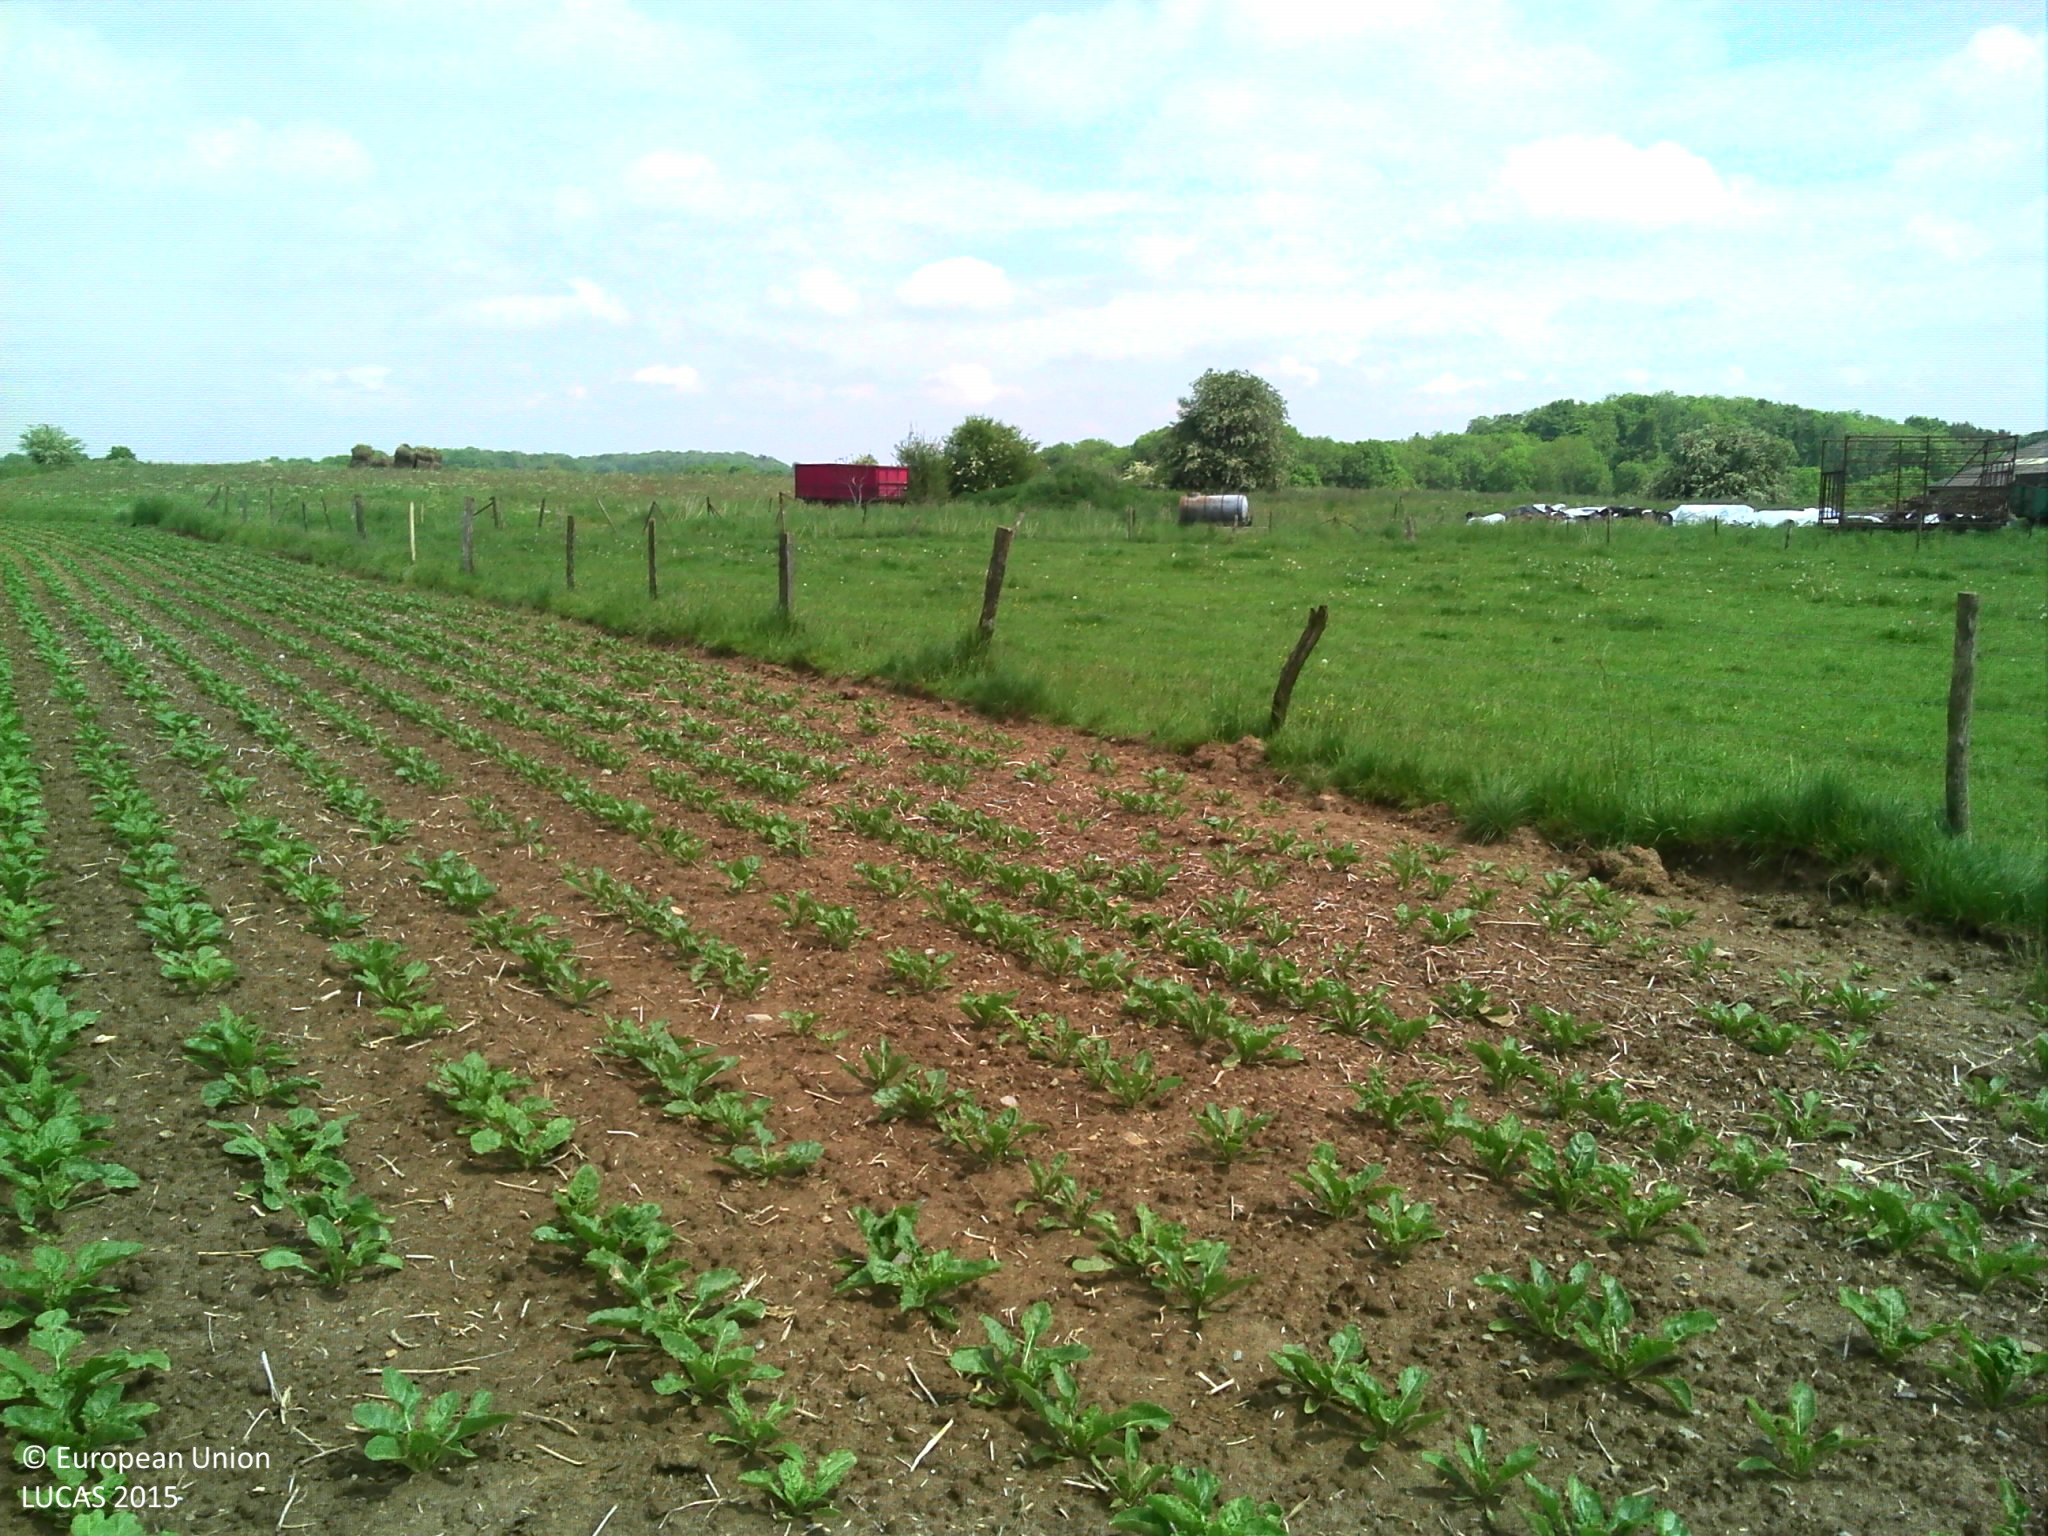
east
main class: Cropland
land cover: Sugar beet
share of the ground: > 75 %
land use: Agriculture (excluding fallow land and kitchen gardens)
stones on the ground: < 10 %
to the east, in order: Sugar beet; Fences; Grassland without tree/shrub cover; Fences; Grass margins; Tracks; Grassland without tree/shrub cover; Fences; Grassland without tree/shrub cover; Artificial constructions in urban areas; Grassland without tree/shrub cover; Fences; Grassland without tree/shrub cover; Fences; Grassland without tree/shrub cover
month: May
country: BE
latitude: 50.4480
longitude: 5.3083
